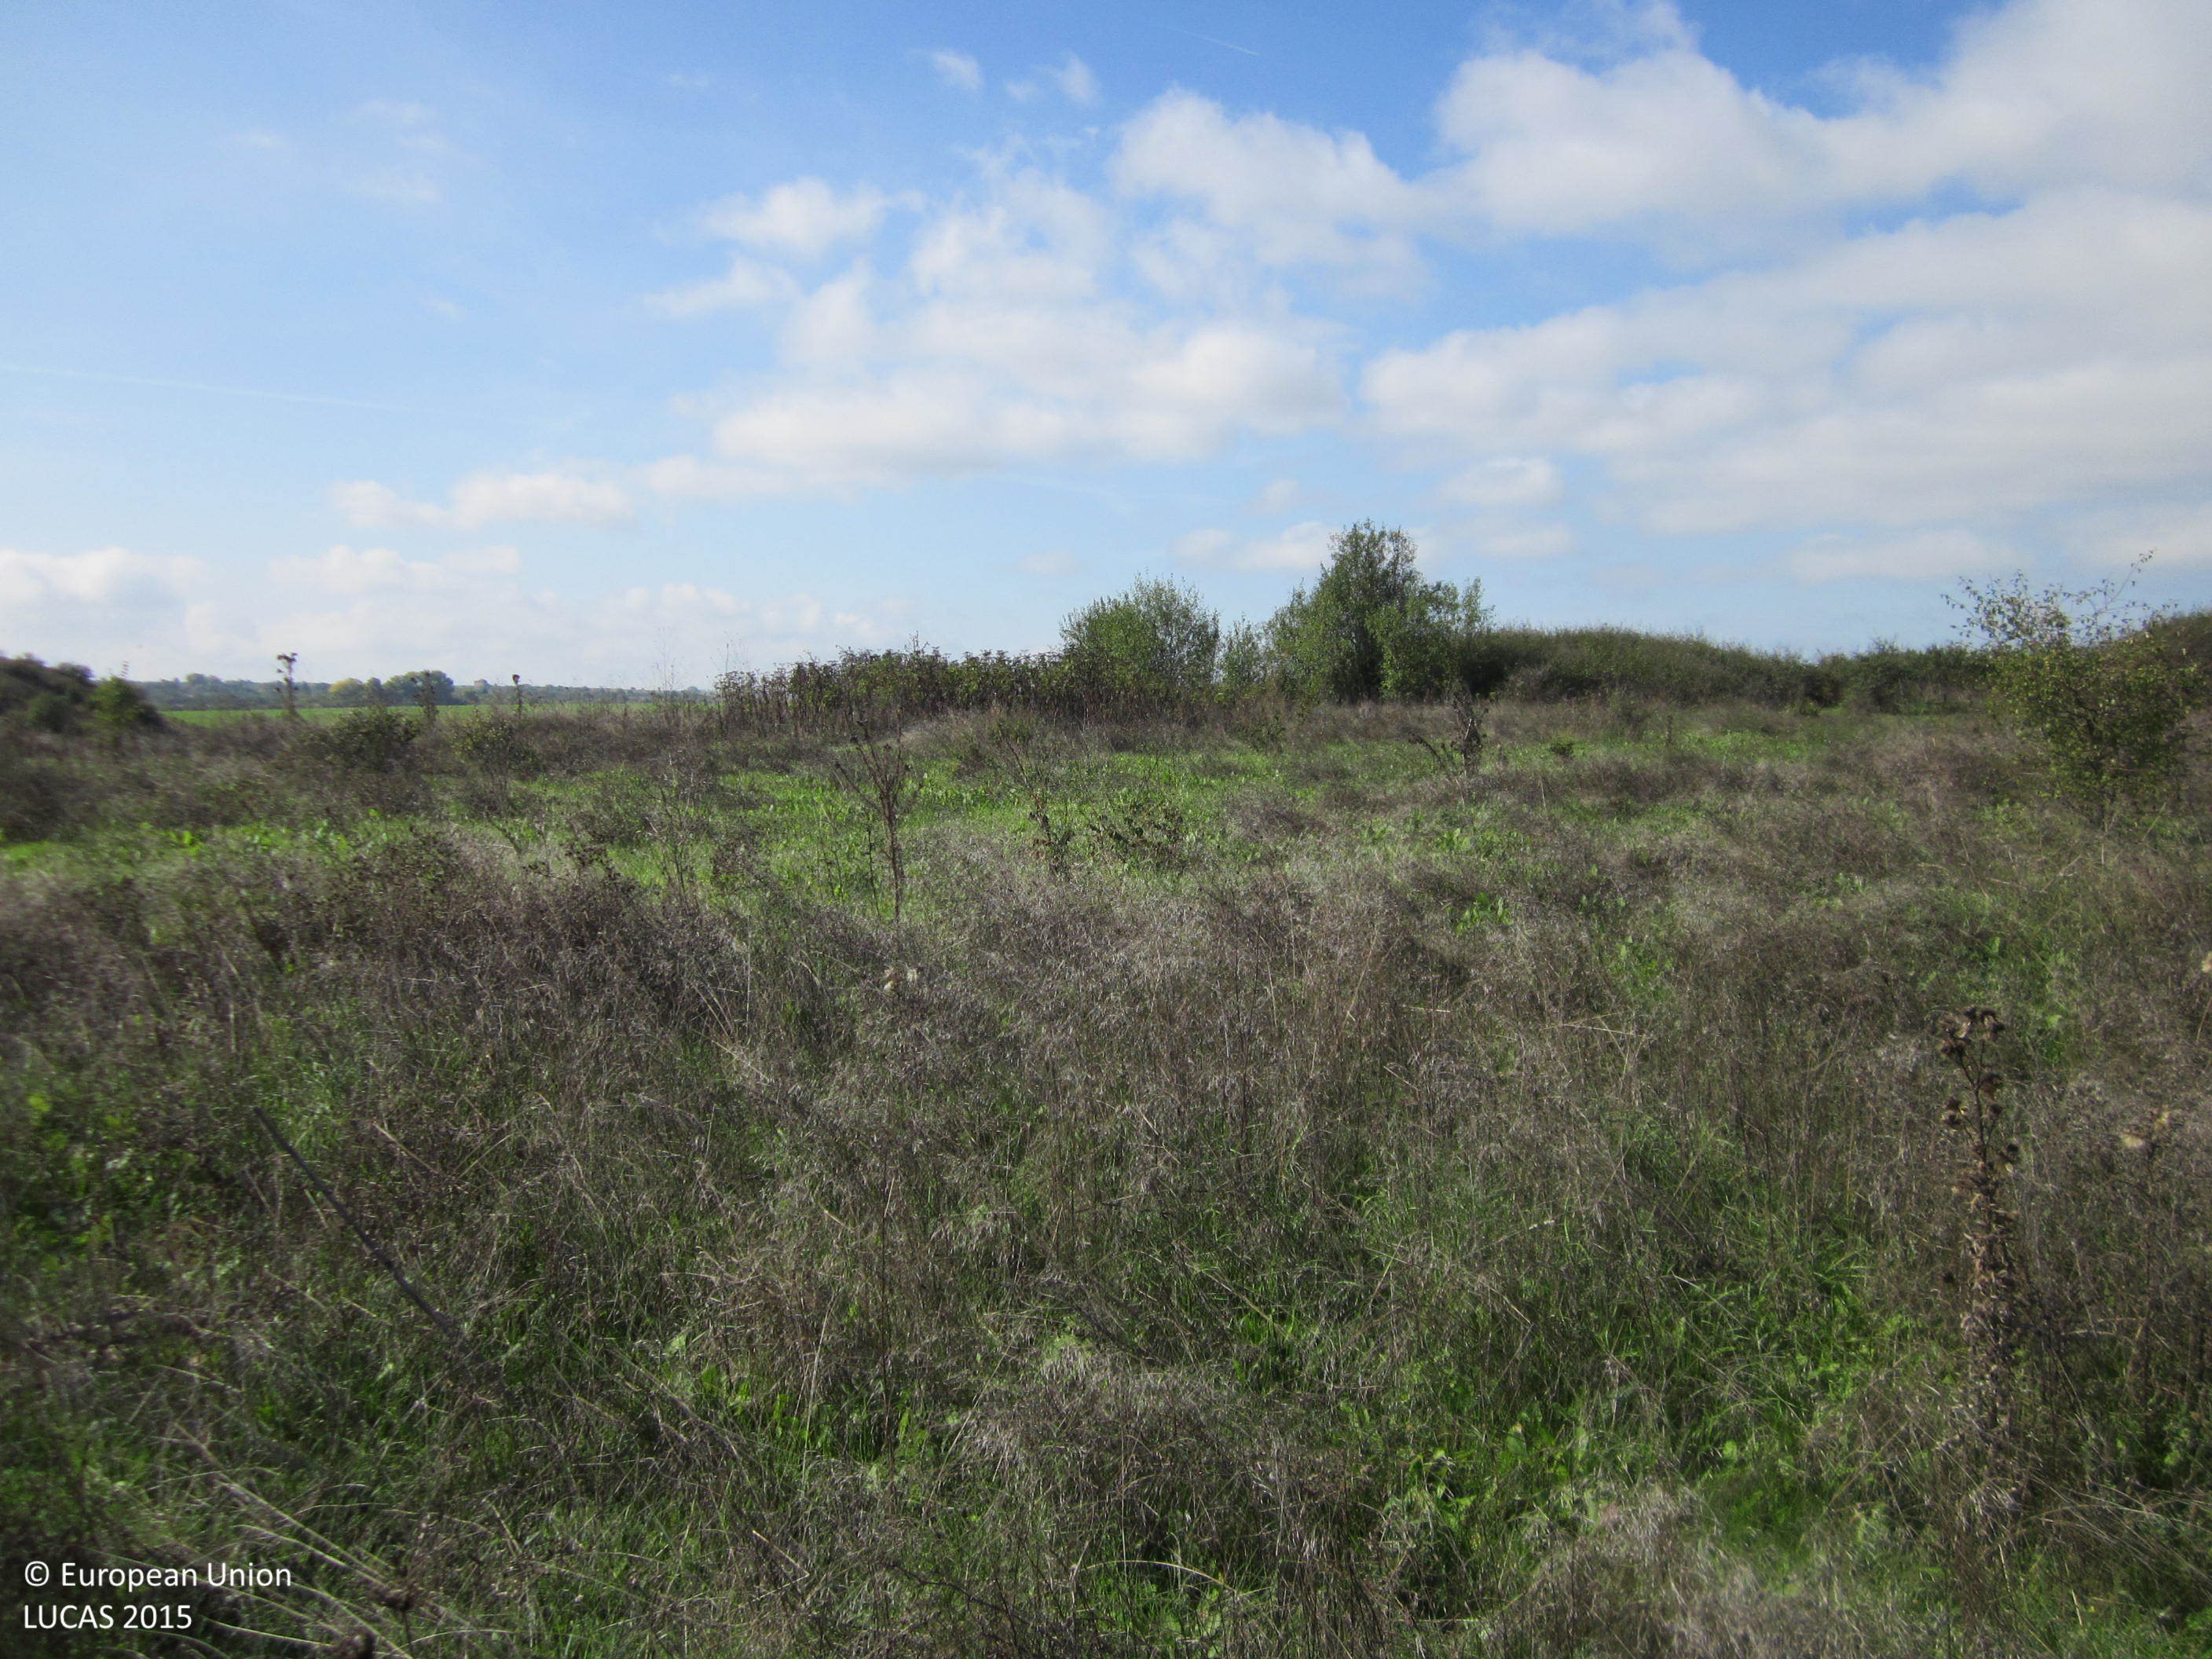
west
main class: Shrubland
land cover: Shrubland with sparse tree cover
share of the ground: 25 - 50 %
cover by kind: herbaceous plants 55 %, shrubs 40 %, broadleaved forest trees 5 %
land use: Semi-natural and natural areas not in use
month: October
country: BG
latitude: 42.7044
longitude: 26.8410
